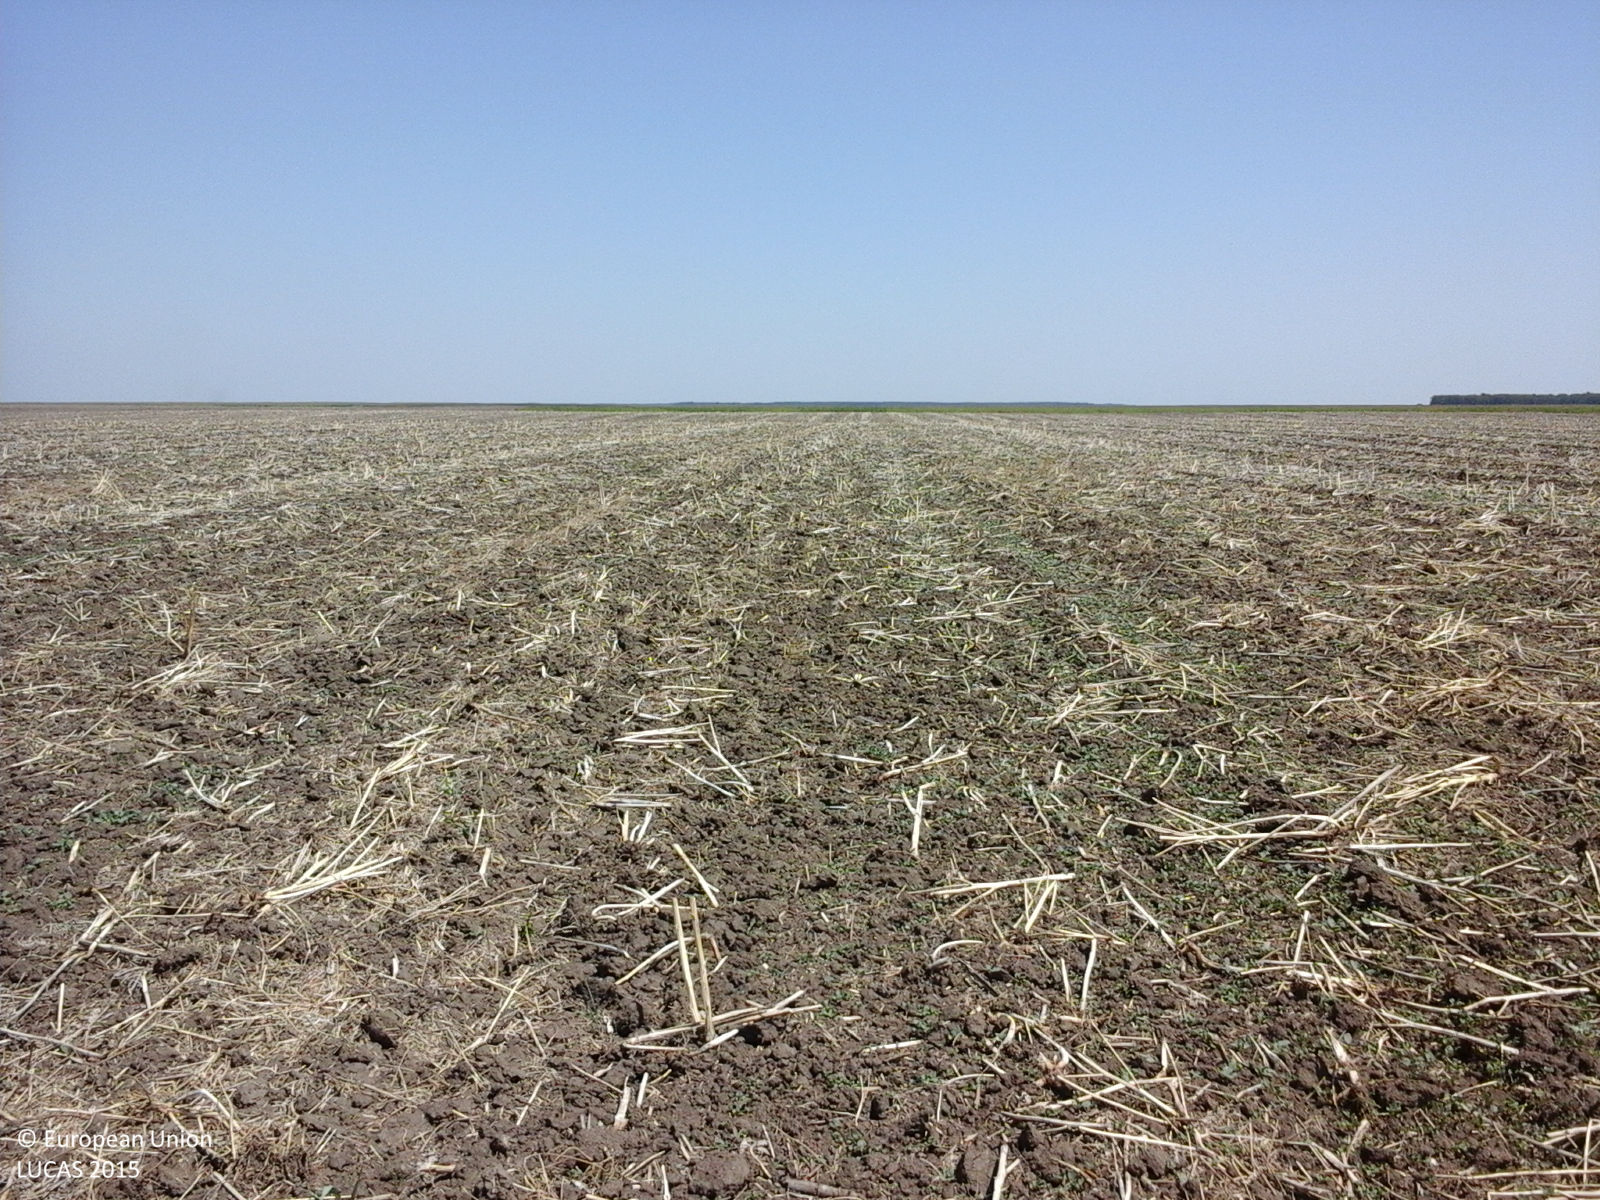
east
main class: Cropland
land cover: Rape and turnip rape
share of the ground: < 10 %
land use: Agriculture (excluding fallow land and kitchen gardens)
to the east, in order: Rape and turnip rape
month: July
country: RO
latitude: 44.3072
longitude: 26.6007
